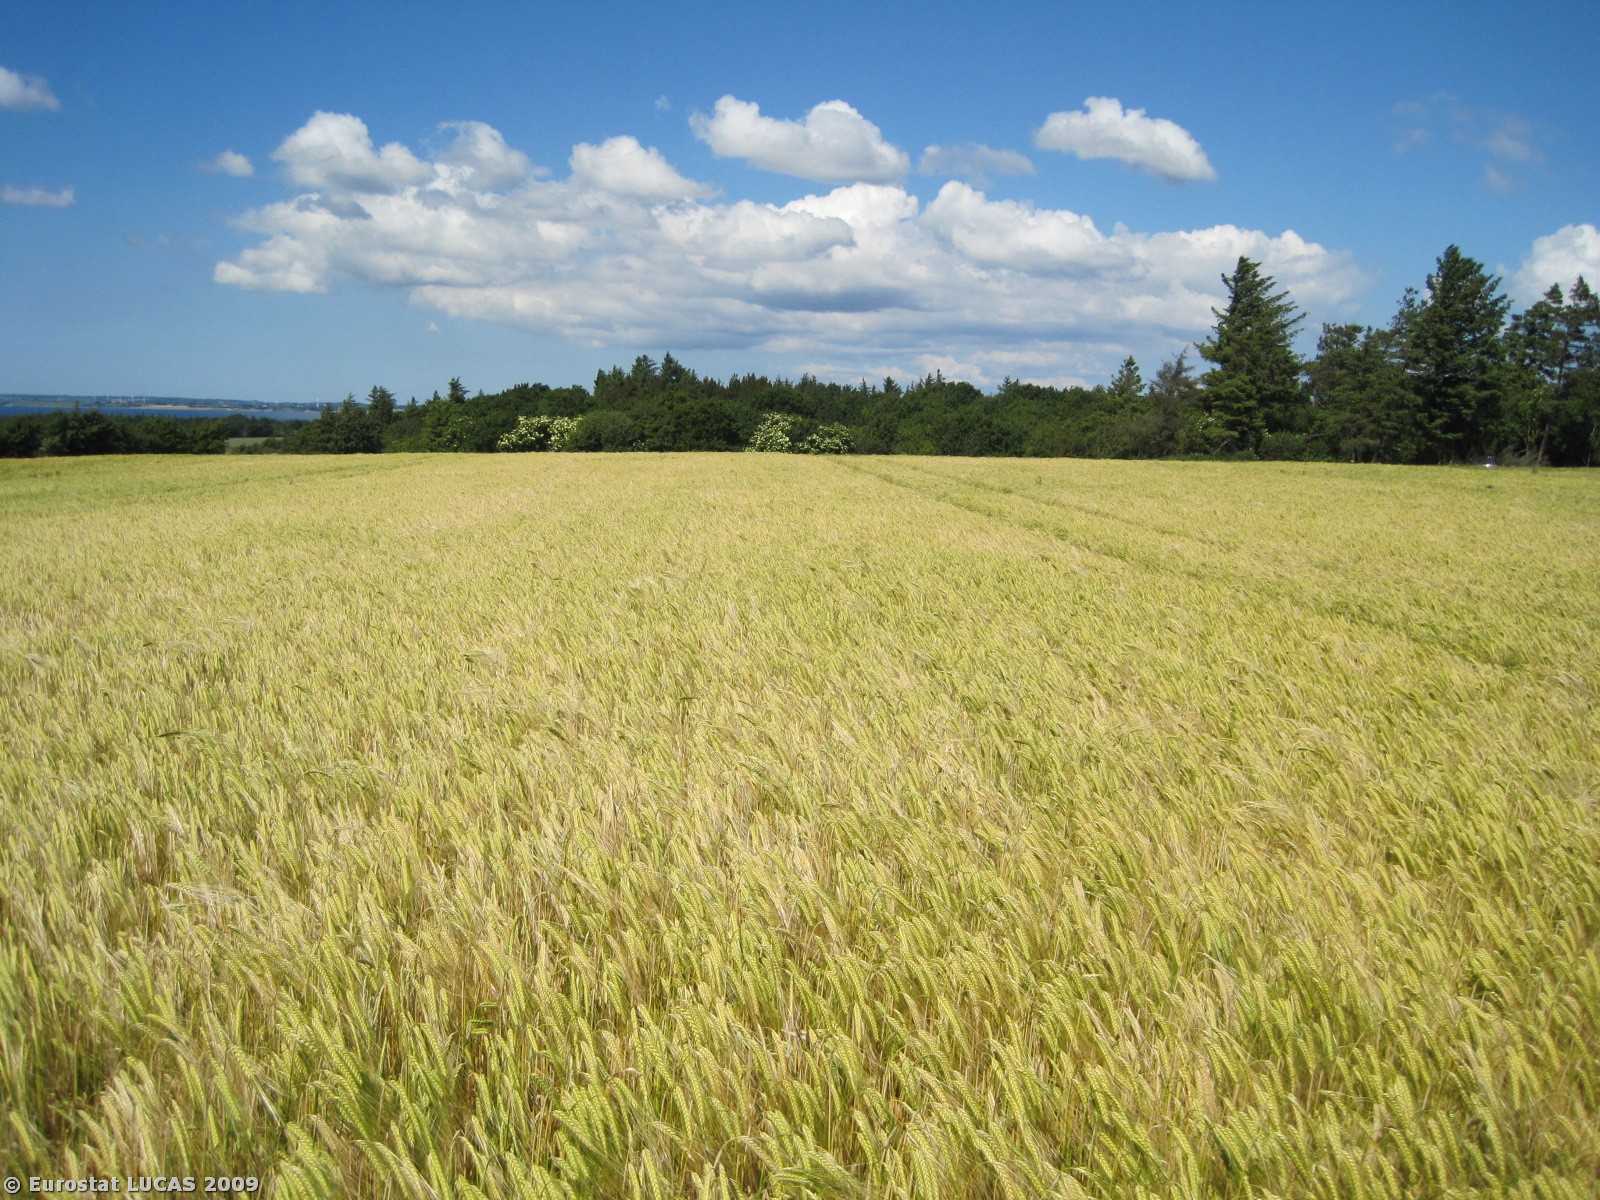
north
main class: Cropland
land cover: Barley
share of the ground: > 75 %
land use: Agriculture (excluding fallow land and kitchen gardens)
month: June
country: DK
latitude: 56.6131
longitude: 8.7470
